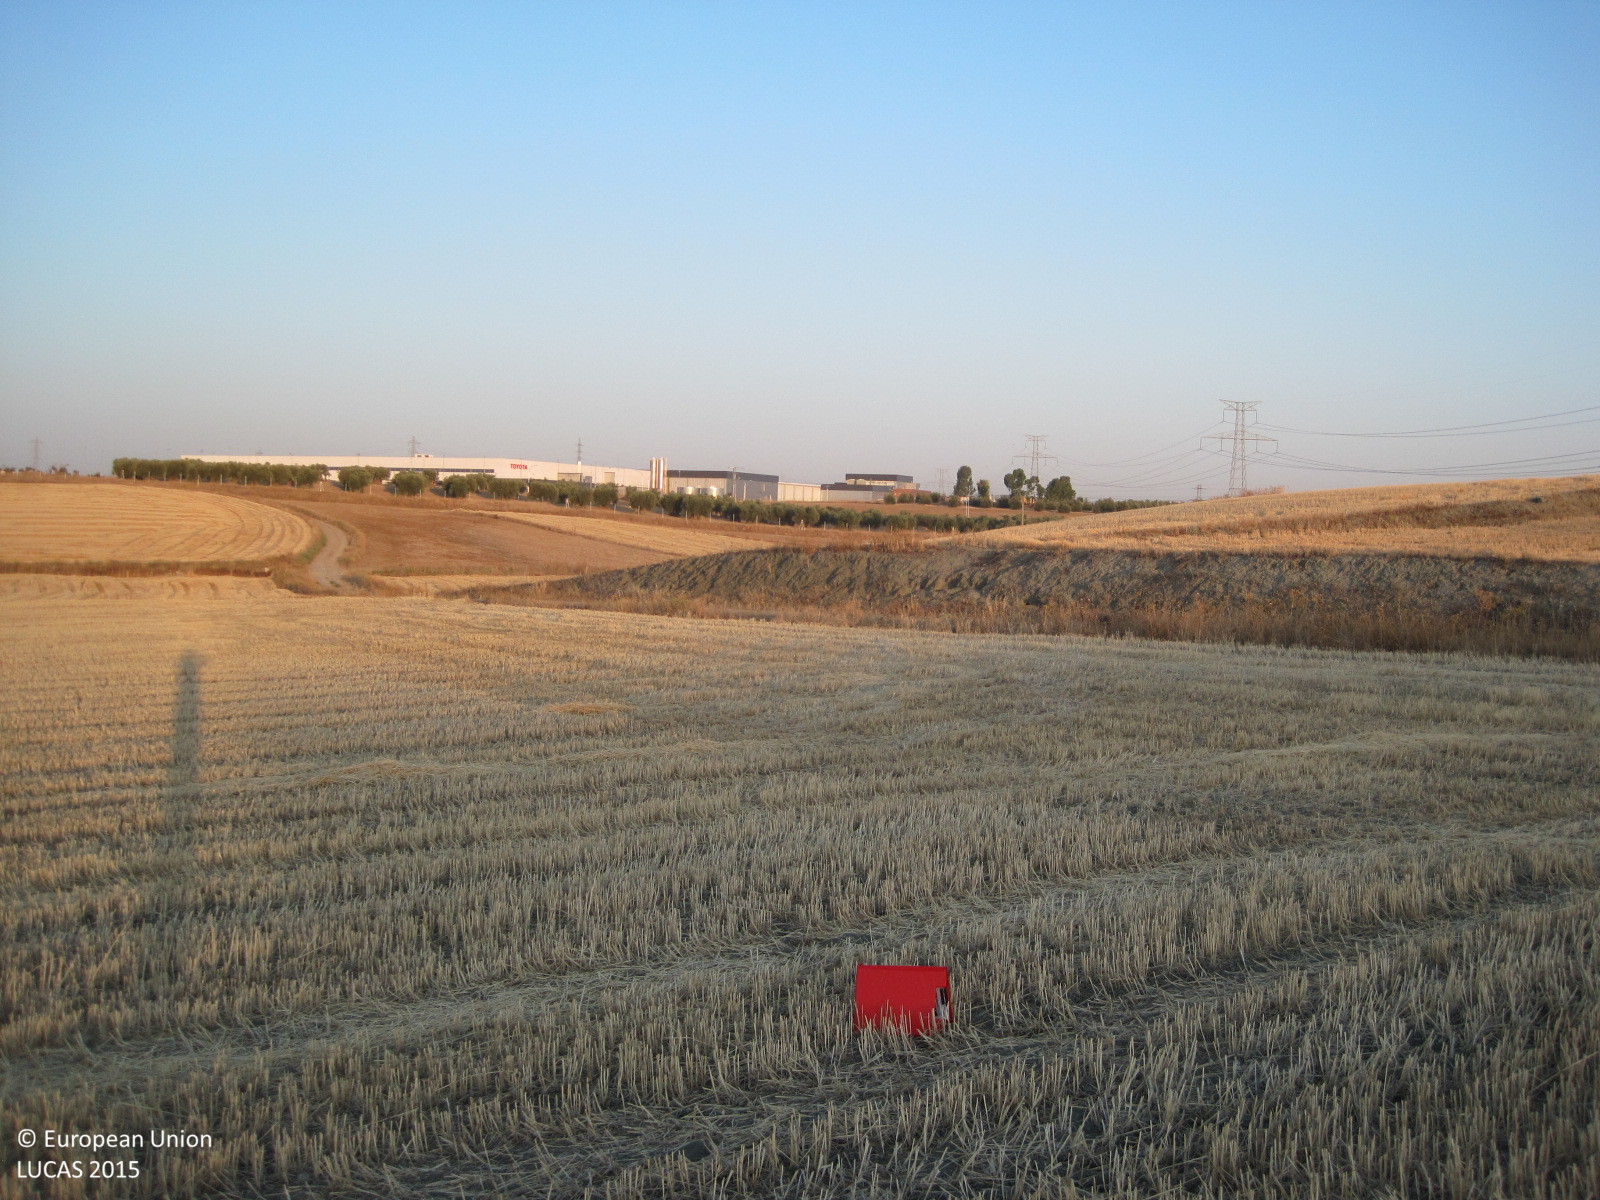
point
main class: Cropland
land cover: Barley
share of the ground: < 10 %
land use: Agriculture (excluding fallow land and kitchen gardens)
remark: Harvested field
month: July
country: ES
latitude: 40.1087
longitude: -3.8200
